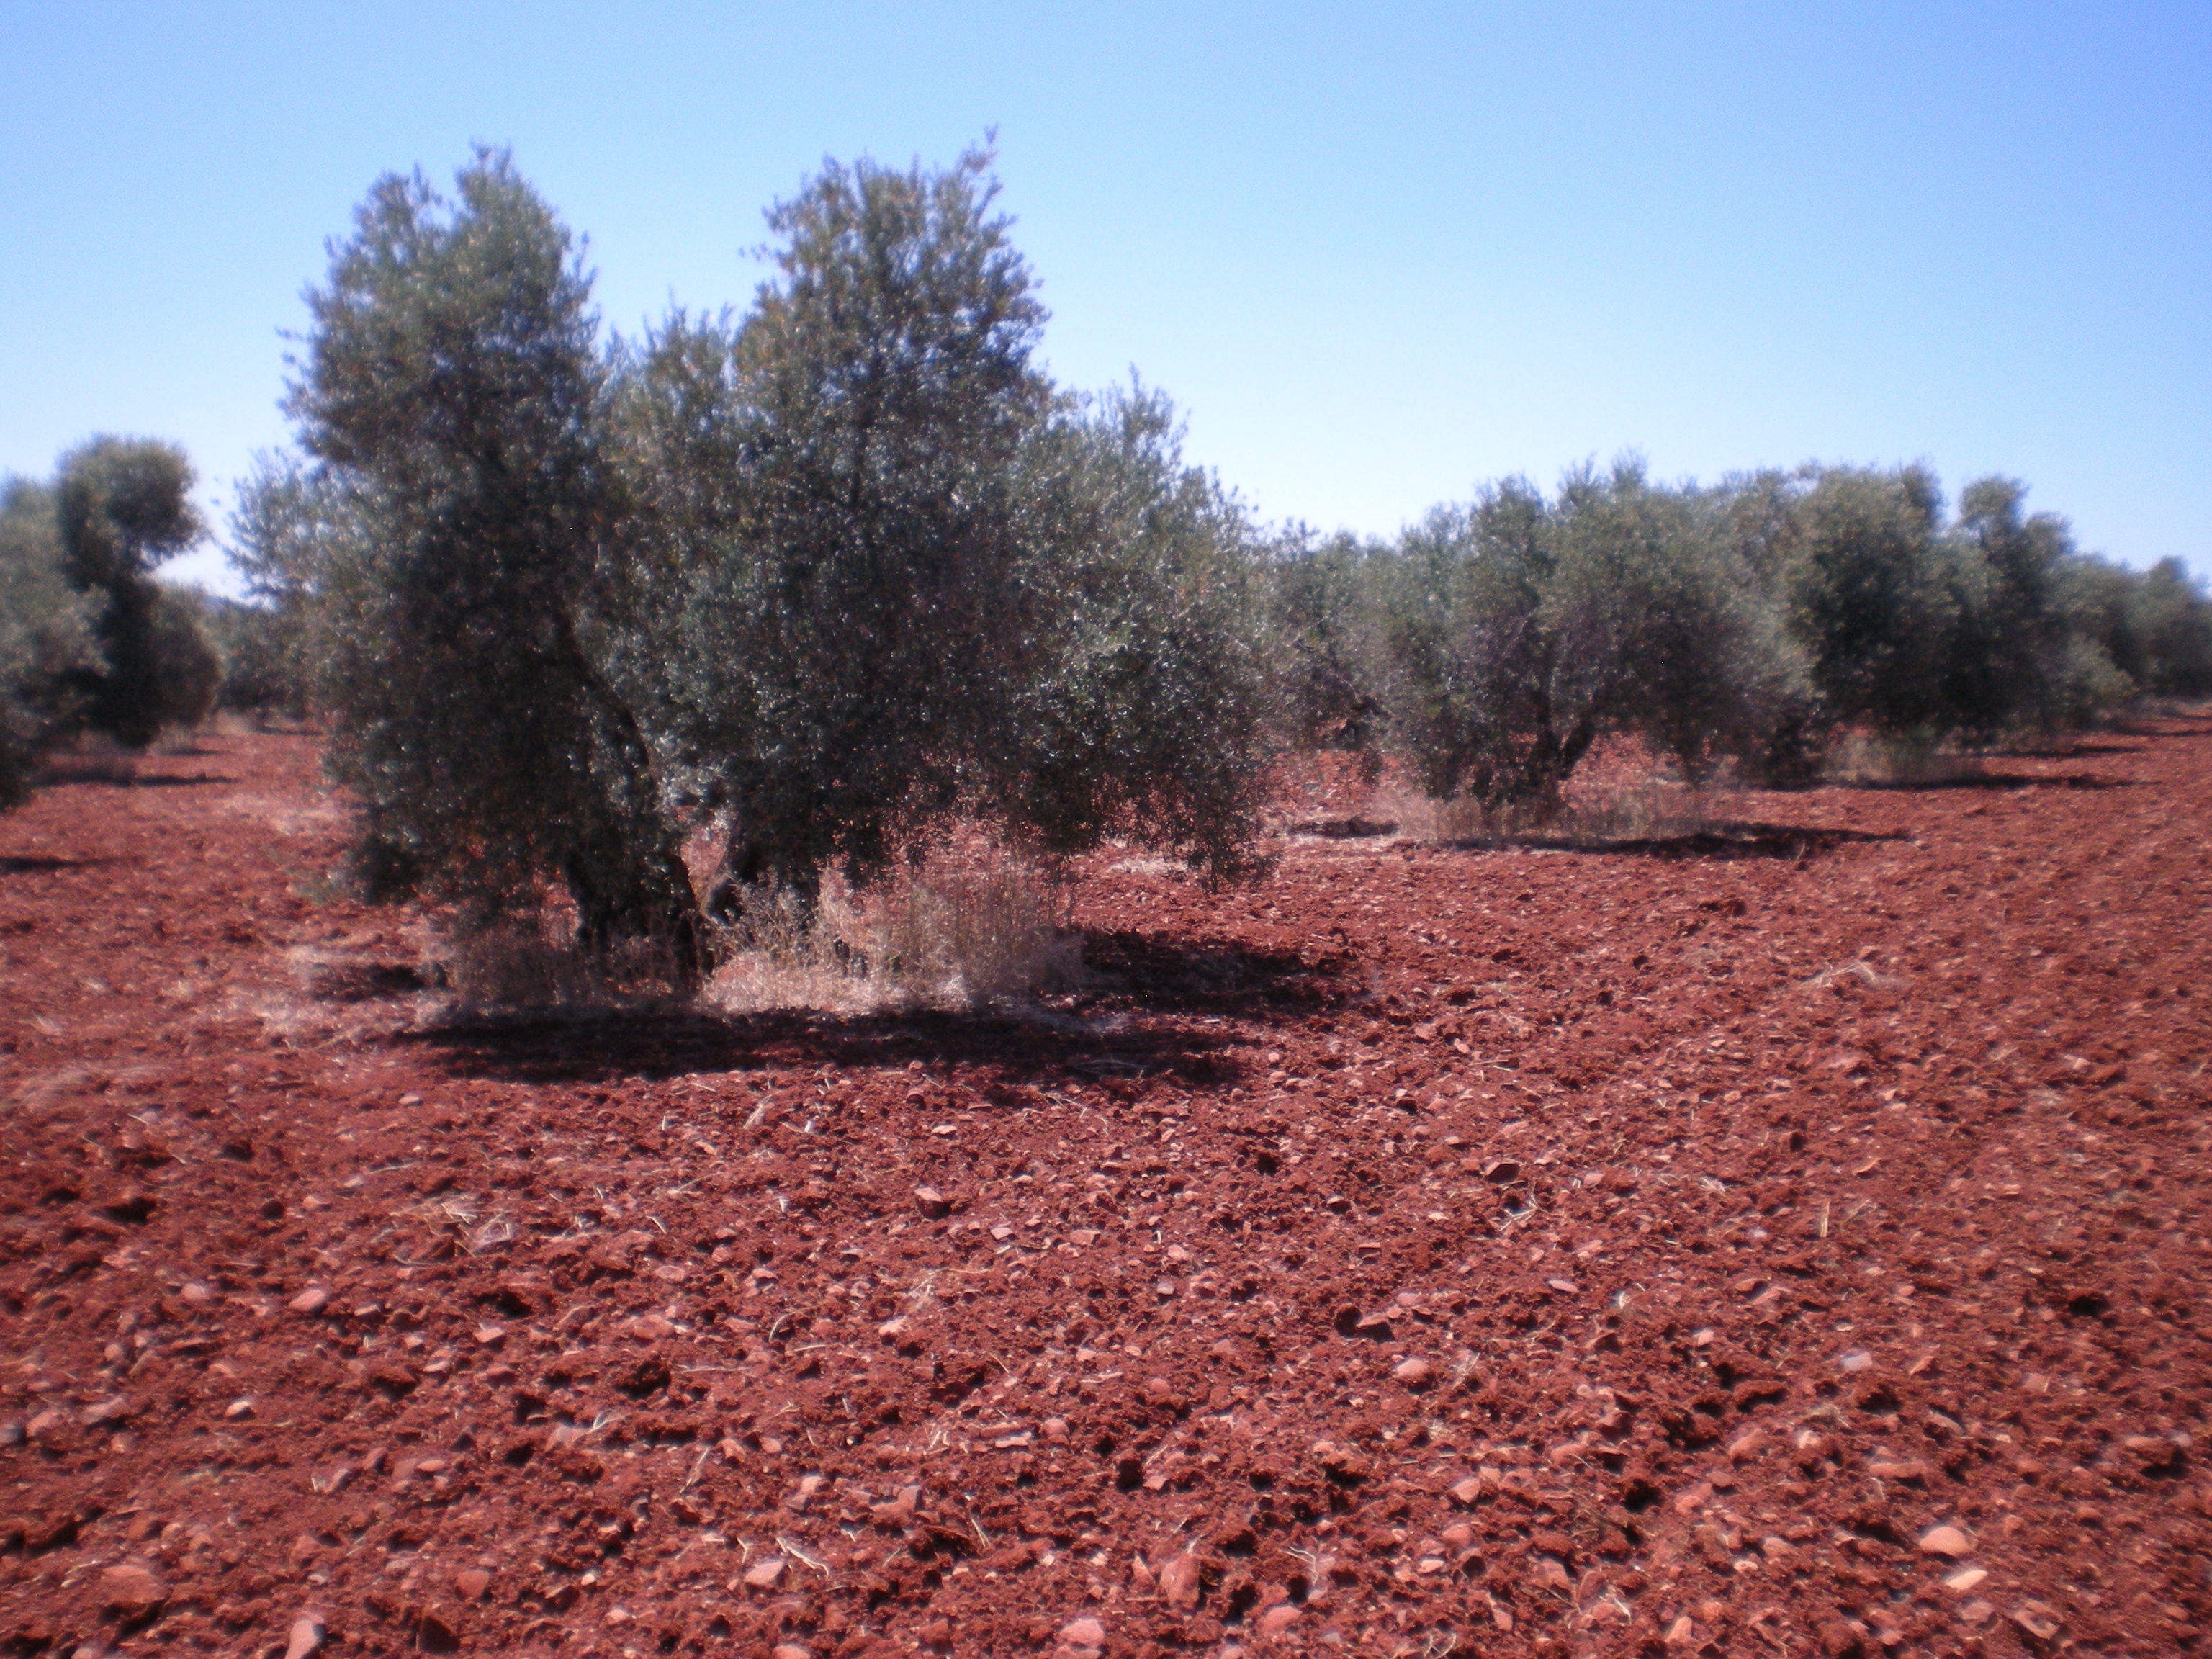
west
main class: Cropland
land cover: Olive groves
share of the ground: 10 - 25 %
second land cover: Other bare soil
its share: > 75 %
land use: Agriculture (excluding fallow land and kitchen gardens)
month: May
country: ES
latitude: 38.5996
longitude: -3.4783
